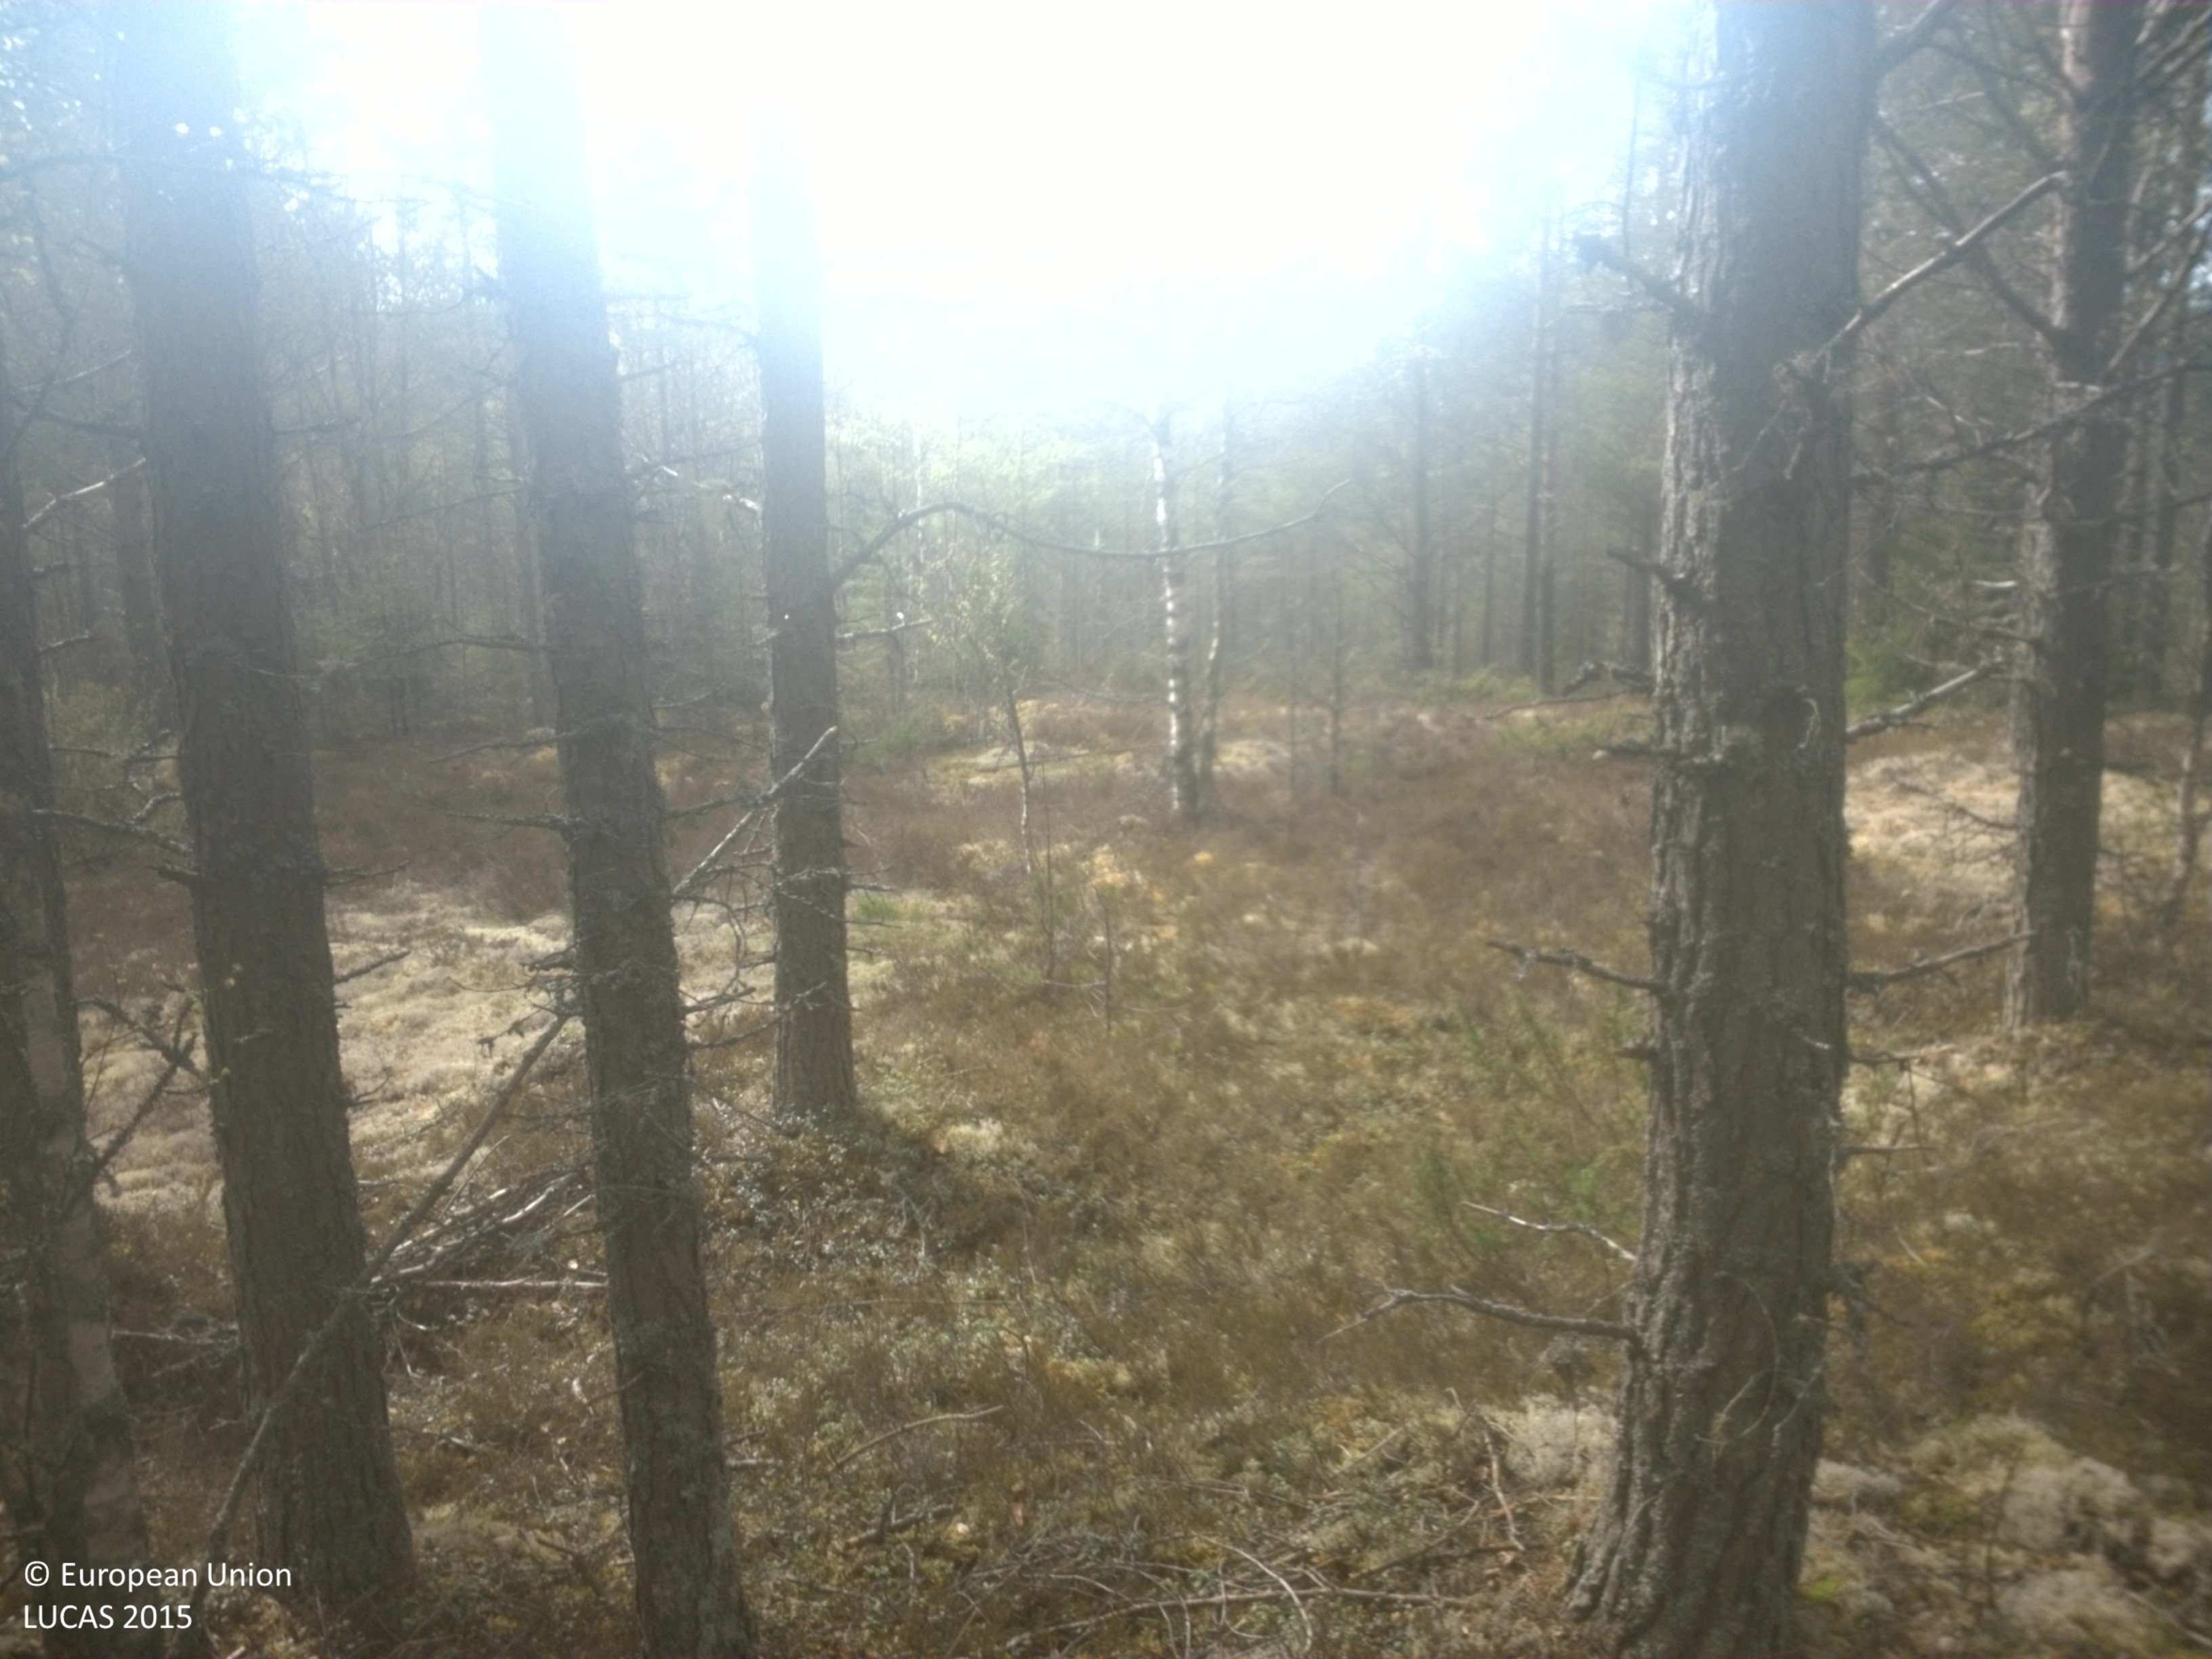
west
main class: Woodland
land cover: Pine dominated coniferous woodland
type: boreal forest
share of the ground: 50 - 75 %
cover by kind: coniferous forest trees 70 %, shrubs 20 %, lichens and mosses 10 %
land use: Forestry
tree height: > 5 m
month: June
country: SE
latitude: 61.0422
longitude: 13.3401
